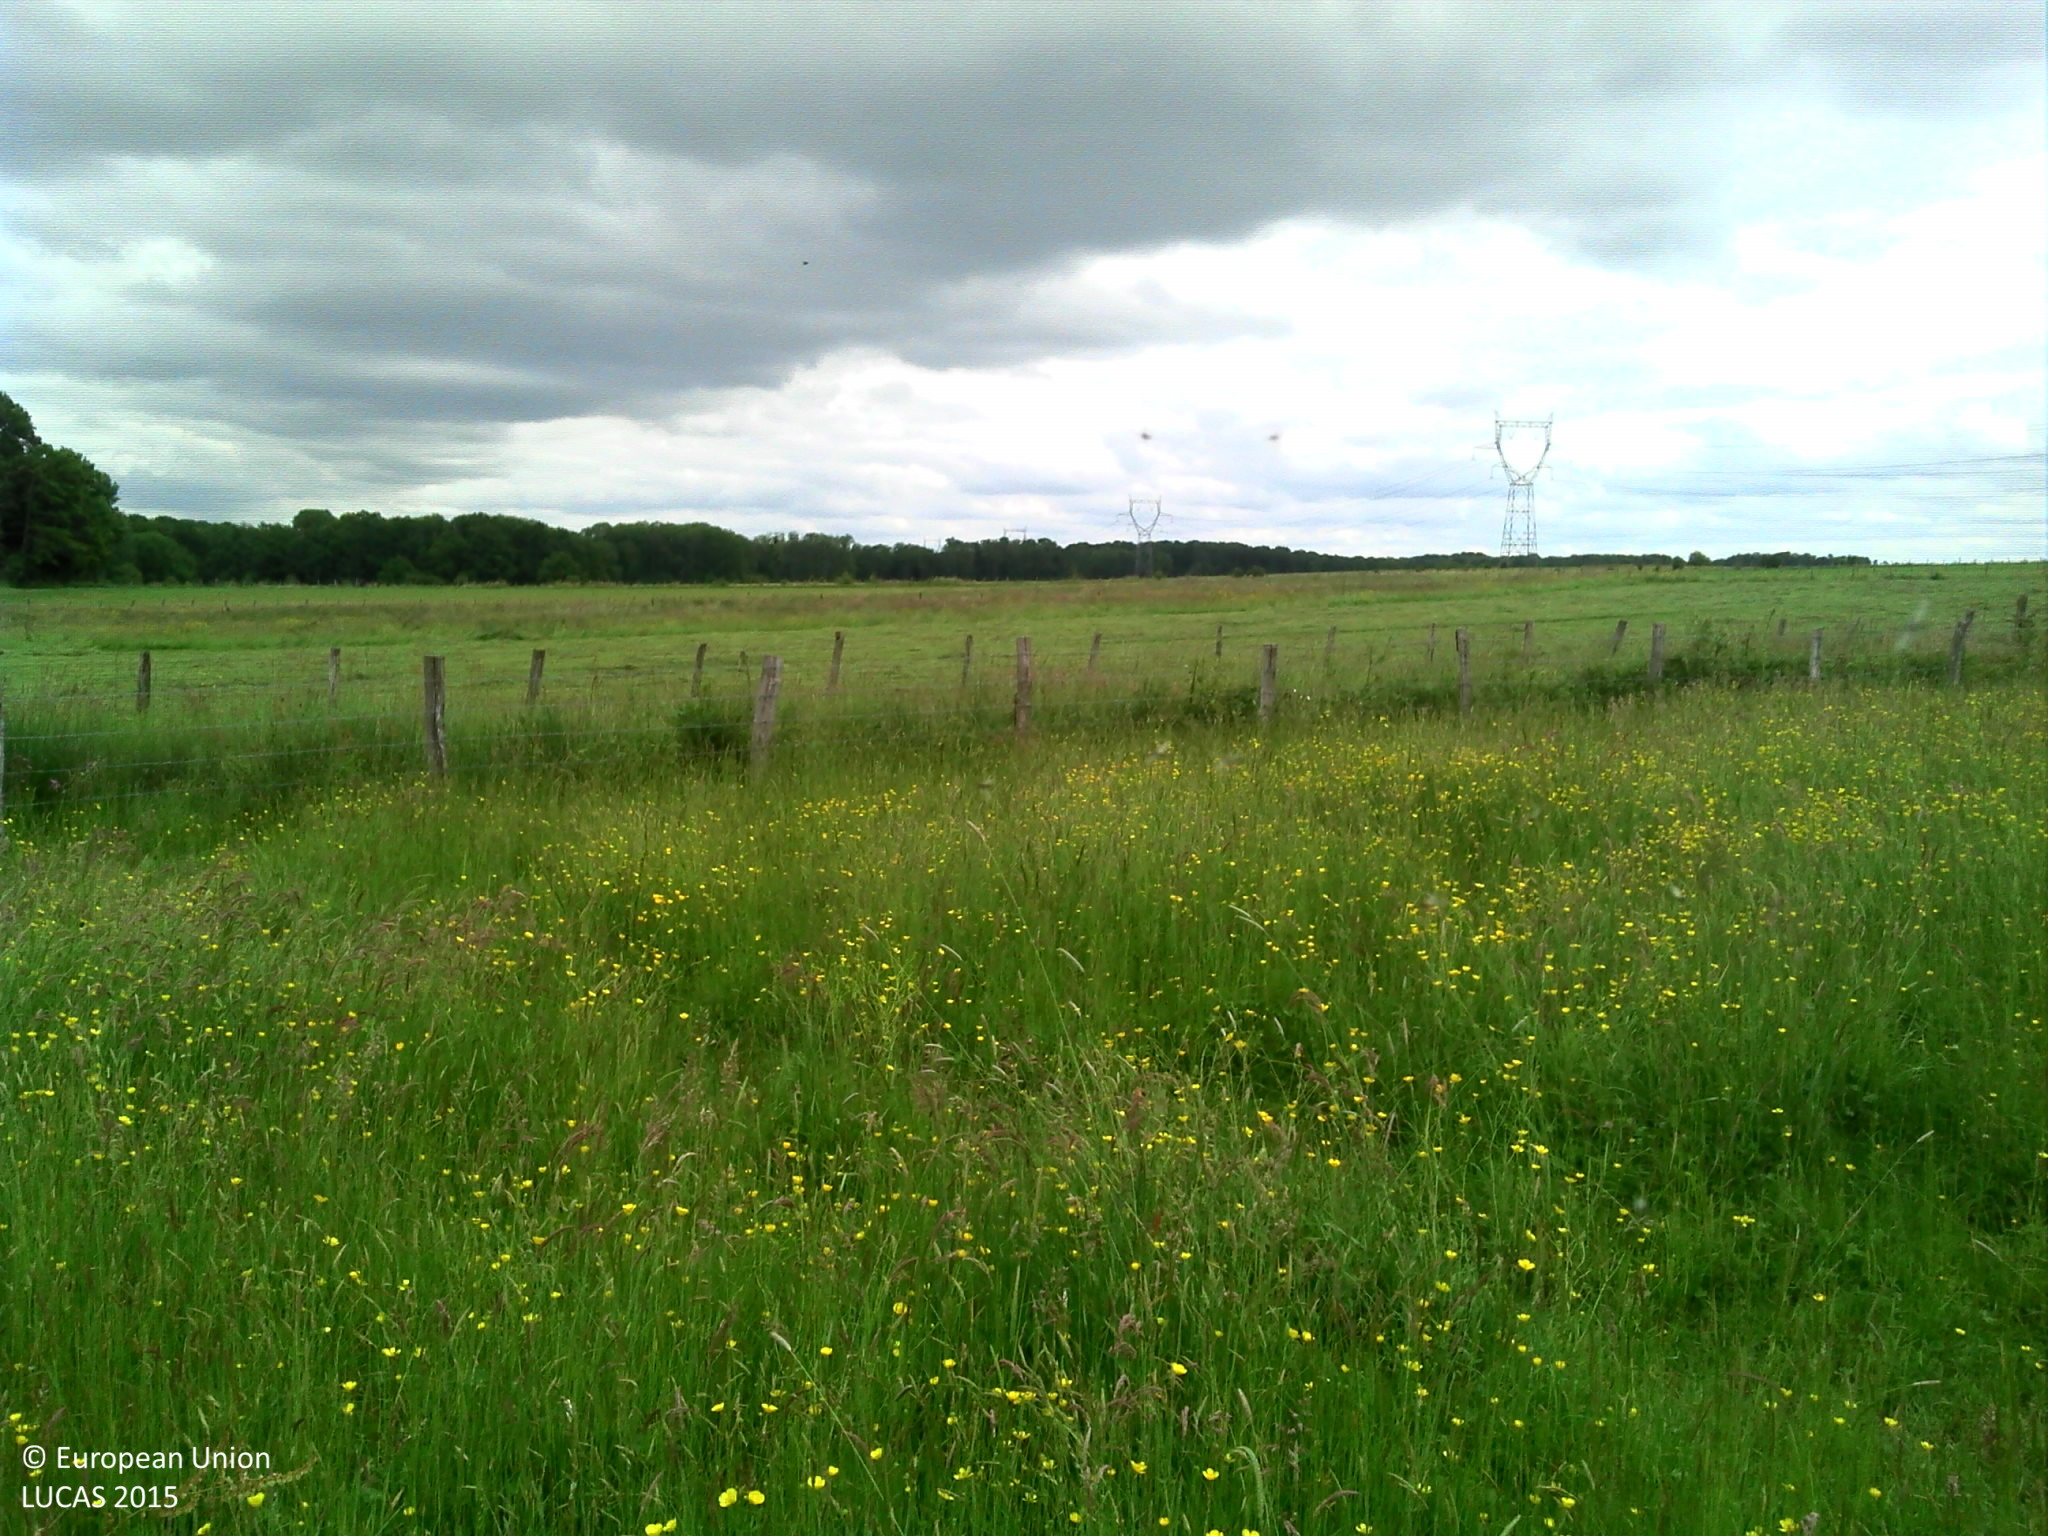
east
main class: Grassland
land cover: Grassland without tree/shrub cover
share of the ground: > 75 %
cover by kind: herbaceous plants 100 %
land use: Agriculture (excluding fallow land and kitchen gardens)
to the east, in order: Grassland without tree/shrub cover; Fences; Grass margins; Tracks; Grass margins; Fences; Grassland without tree/shrub cover; Fences; Grassland without tree/shrub cover; Fences; Maize
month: June
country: FR
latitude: 48.5187
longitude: 4.8669
